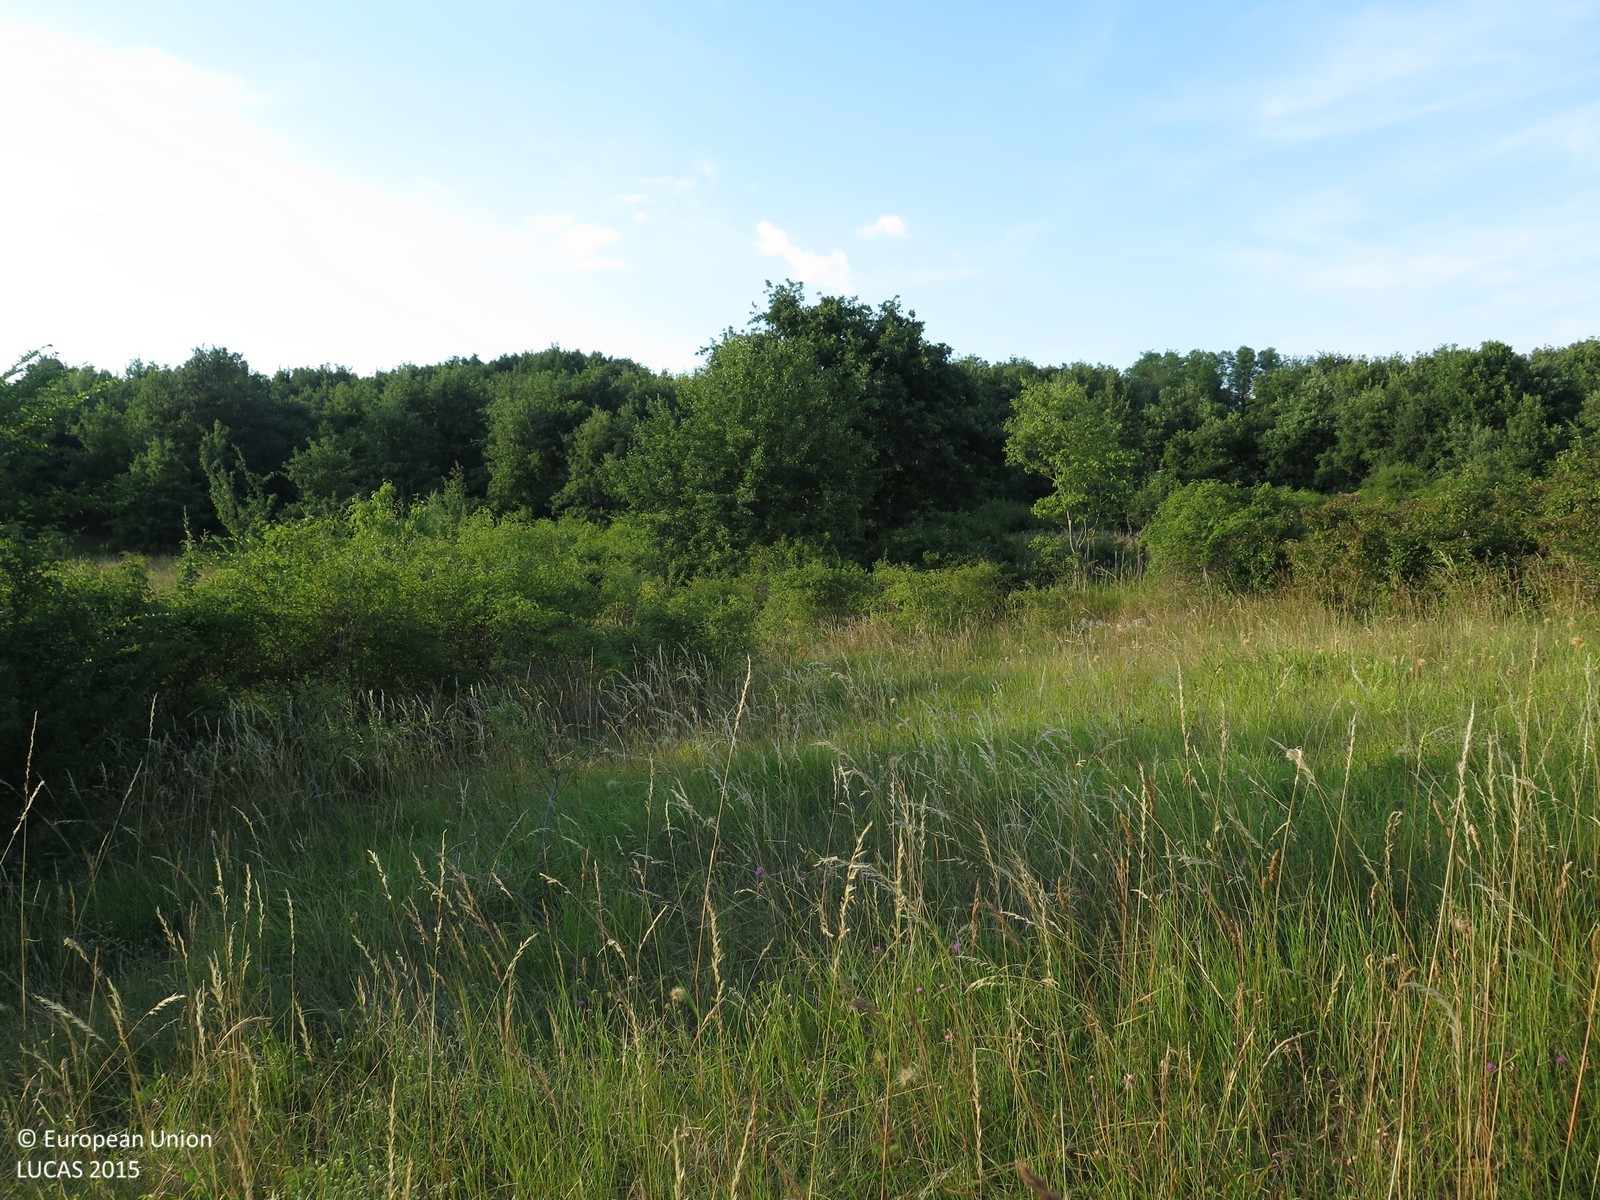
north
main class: Grassland
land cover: Grassland with sparse tree/shrub cover
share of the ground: > 75 %
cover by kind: herbaceous plants 90 %, broadleaved forest trees 5 %, shrubs 5 %
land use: Abandoned areas
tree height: > 5 m
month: June
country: HR
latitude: 45.1200
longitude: 14.0498
